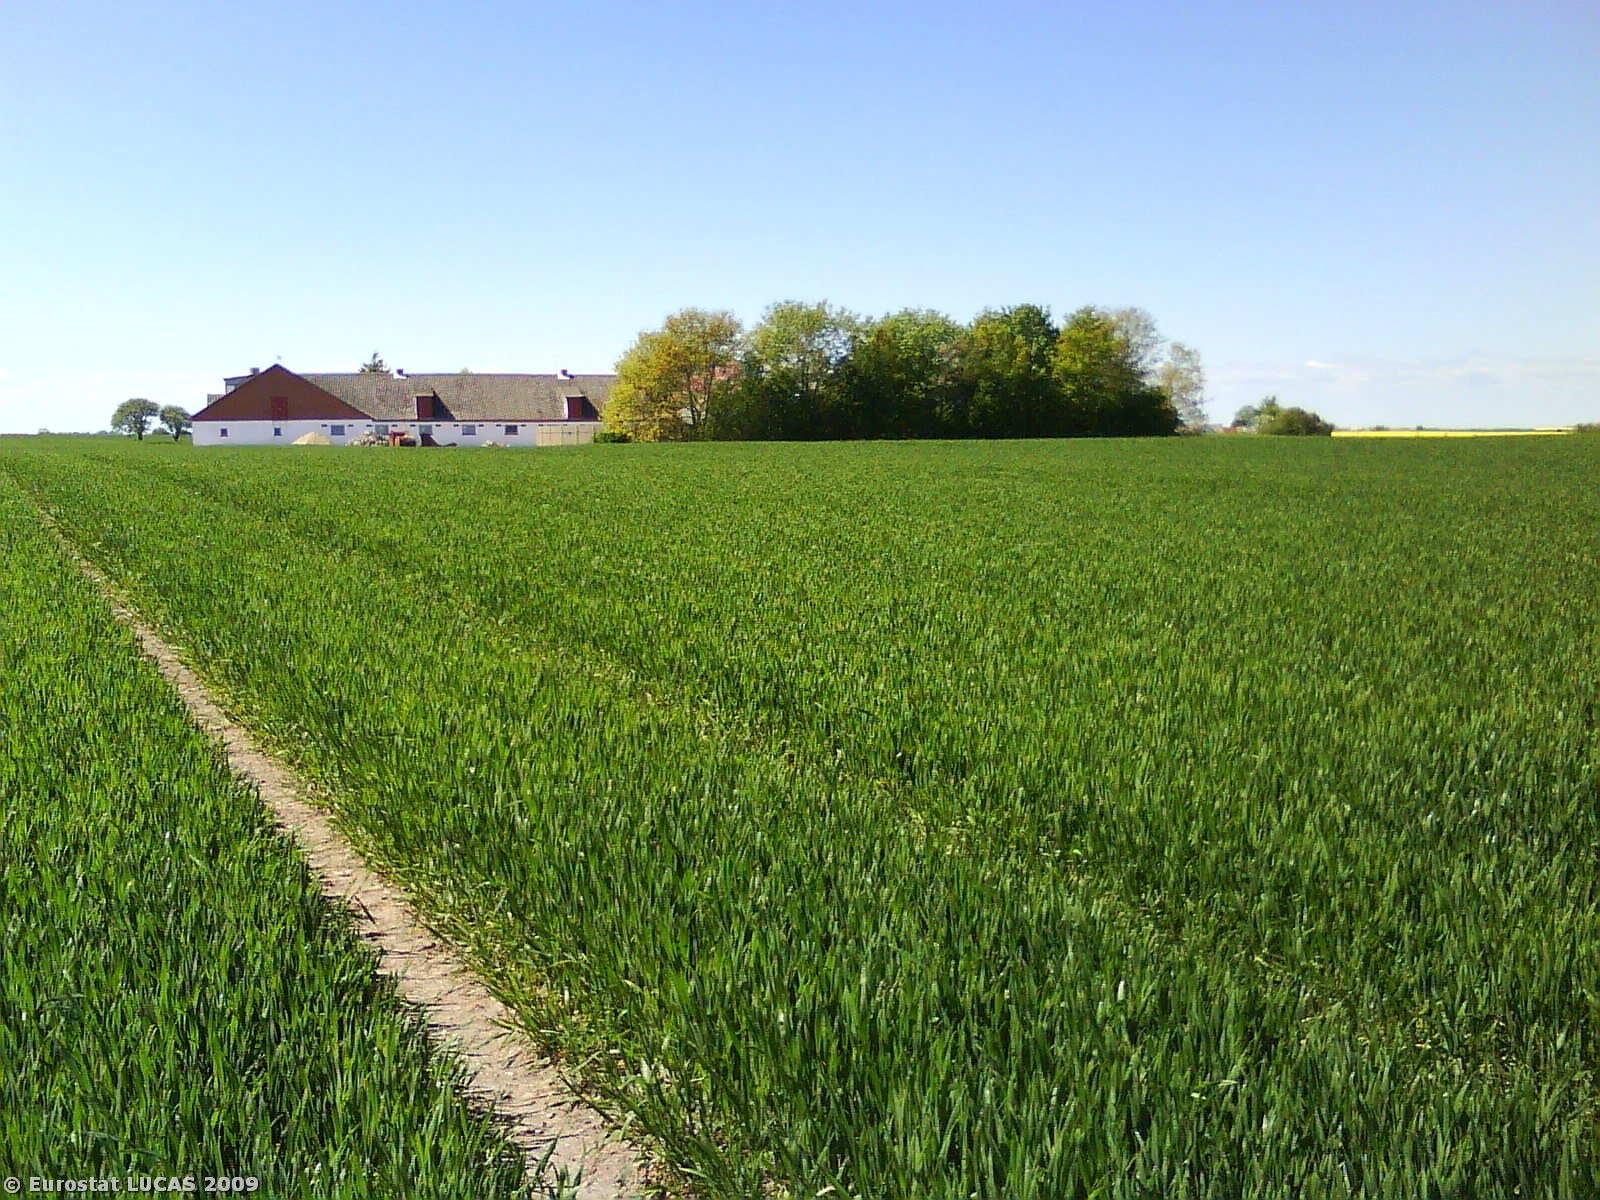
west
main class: Cropland
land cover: Common wheat
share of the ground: > 75 %
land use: Agriculture (excluding fallow land and kitchen gardens)
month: May
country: DK
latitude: 56.4723
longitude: 10.8917
